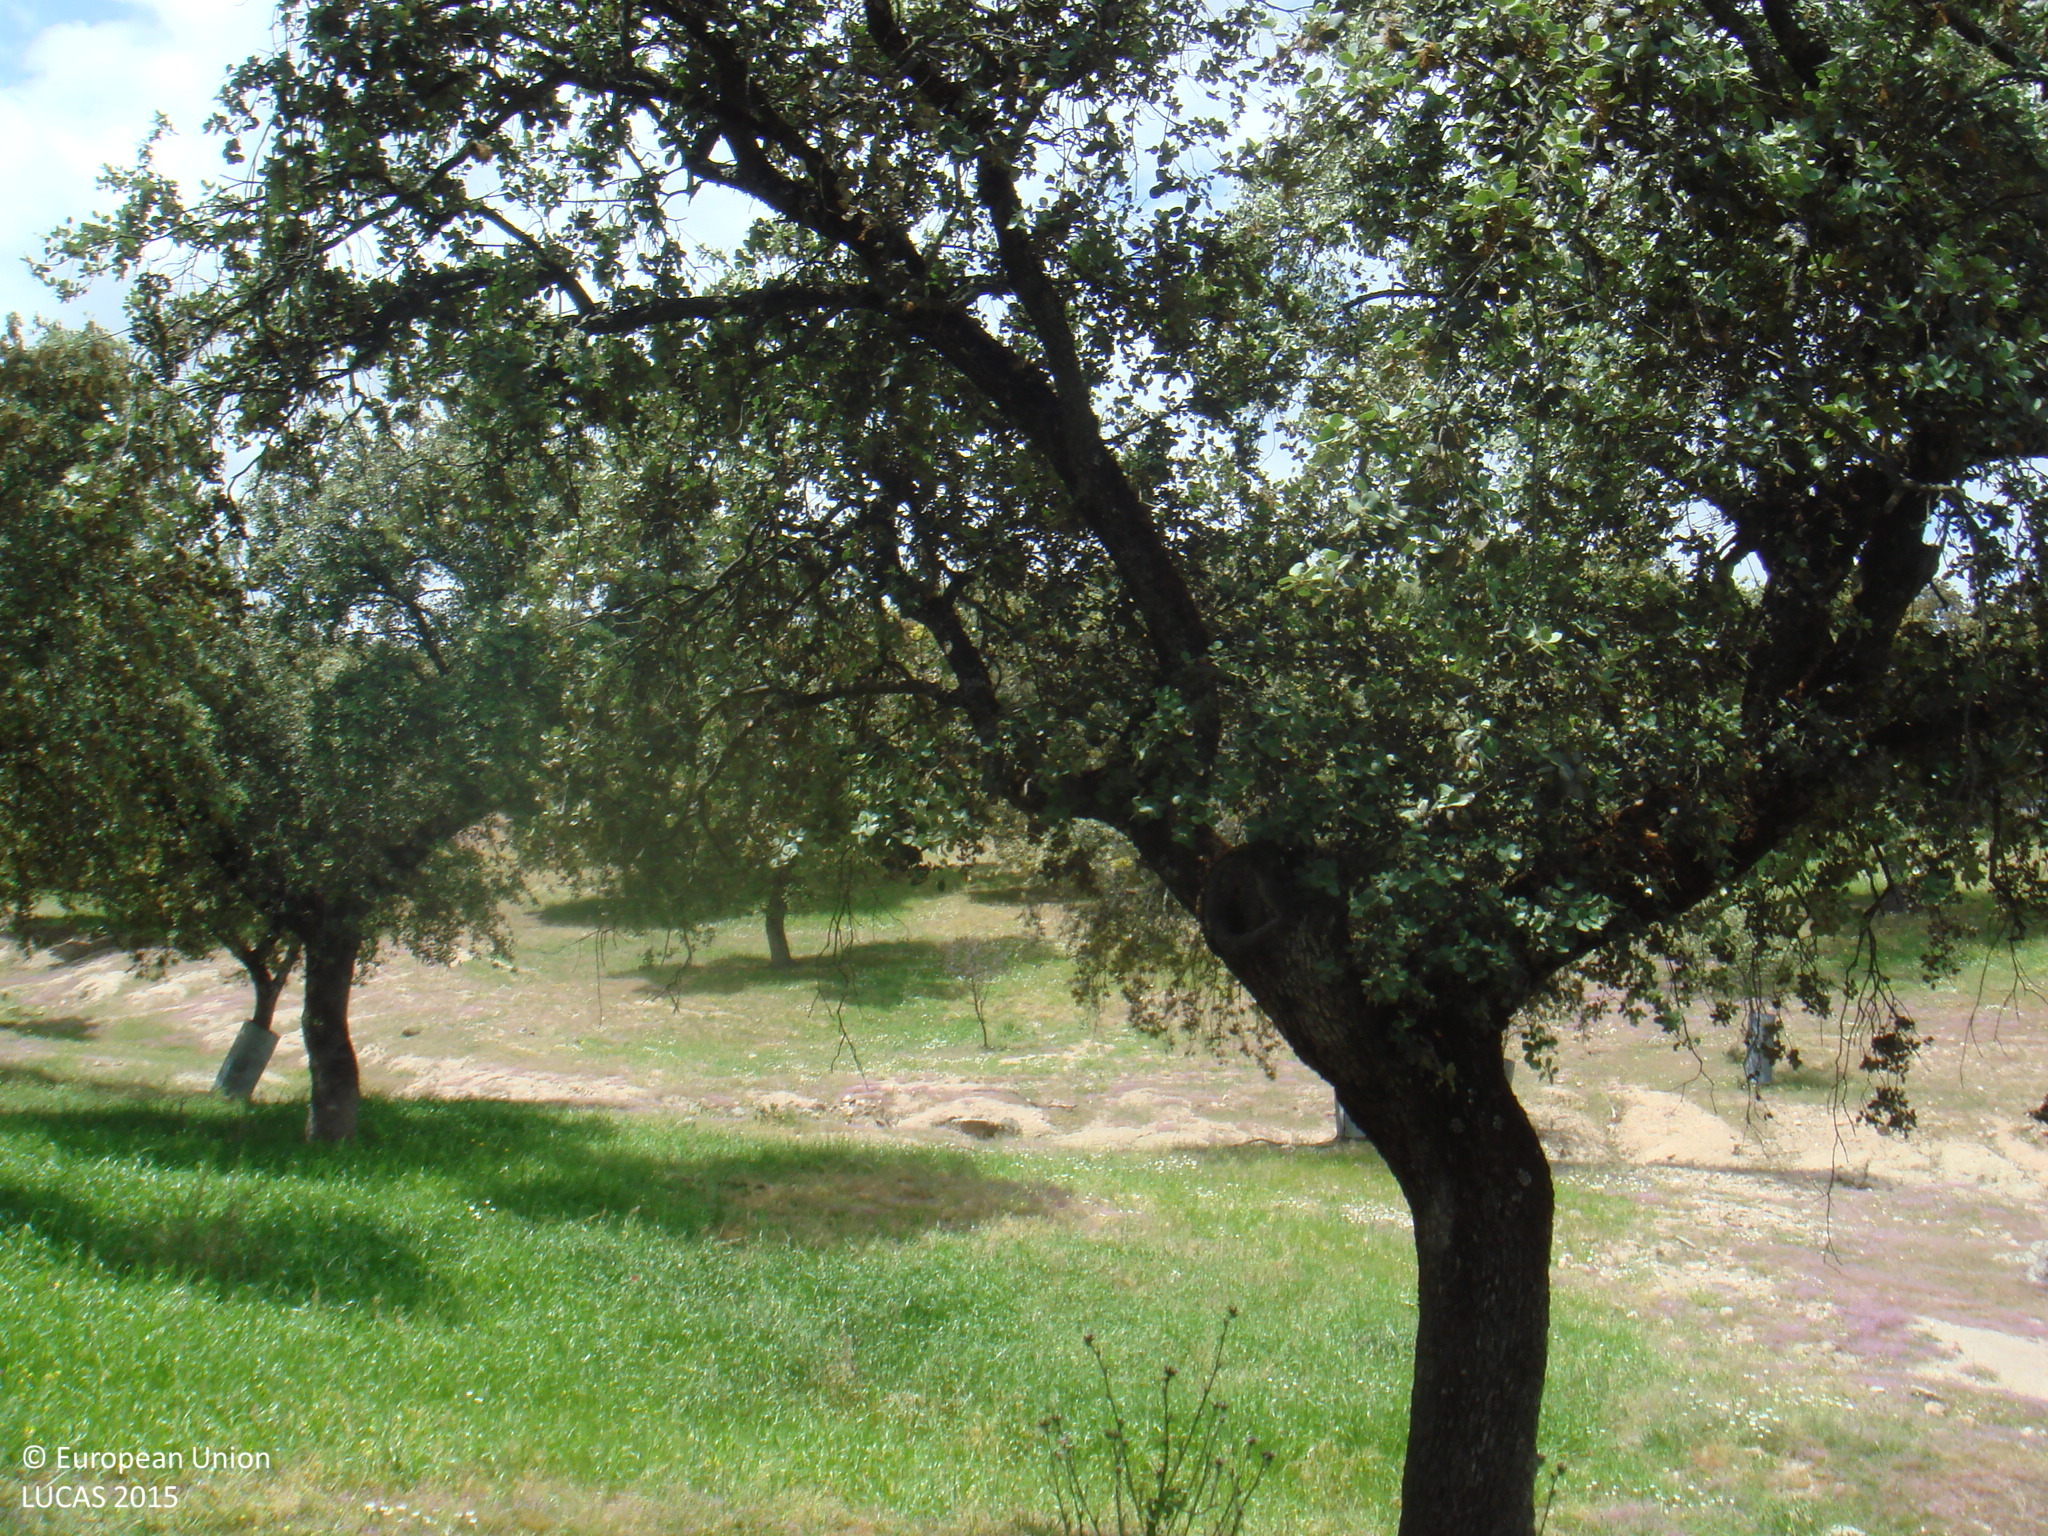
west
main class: Woodland
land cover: Broadleaved woodland
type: broadleaved evergreen forest
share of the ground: 50 - 75 %
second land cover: Spontaneously vegetated surfaces
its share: > 75 %
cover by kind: herbaceous plants 60 %, broadleaved forest trees 40 %
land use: Forestry
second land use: Agriculture (excluding fallow land and kitchen gardens)
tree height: > 5 m
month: May
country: ES
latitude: 38.3111
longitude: -4.3224
